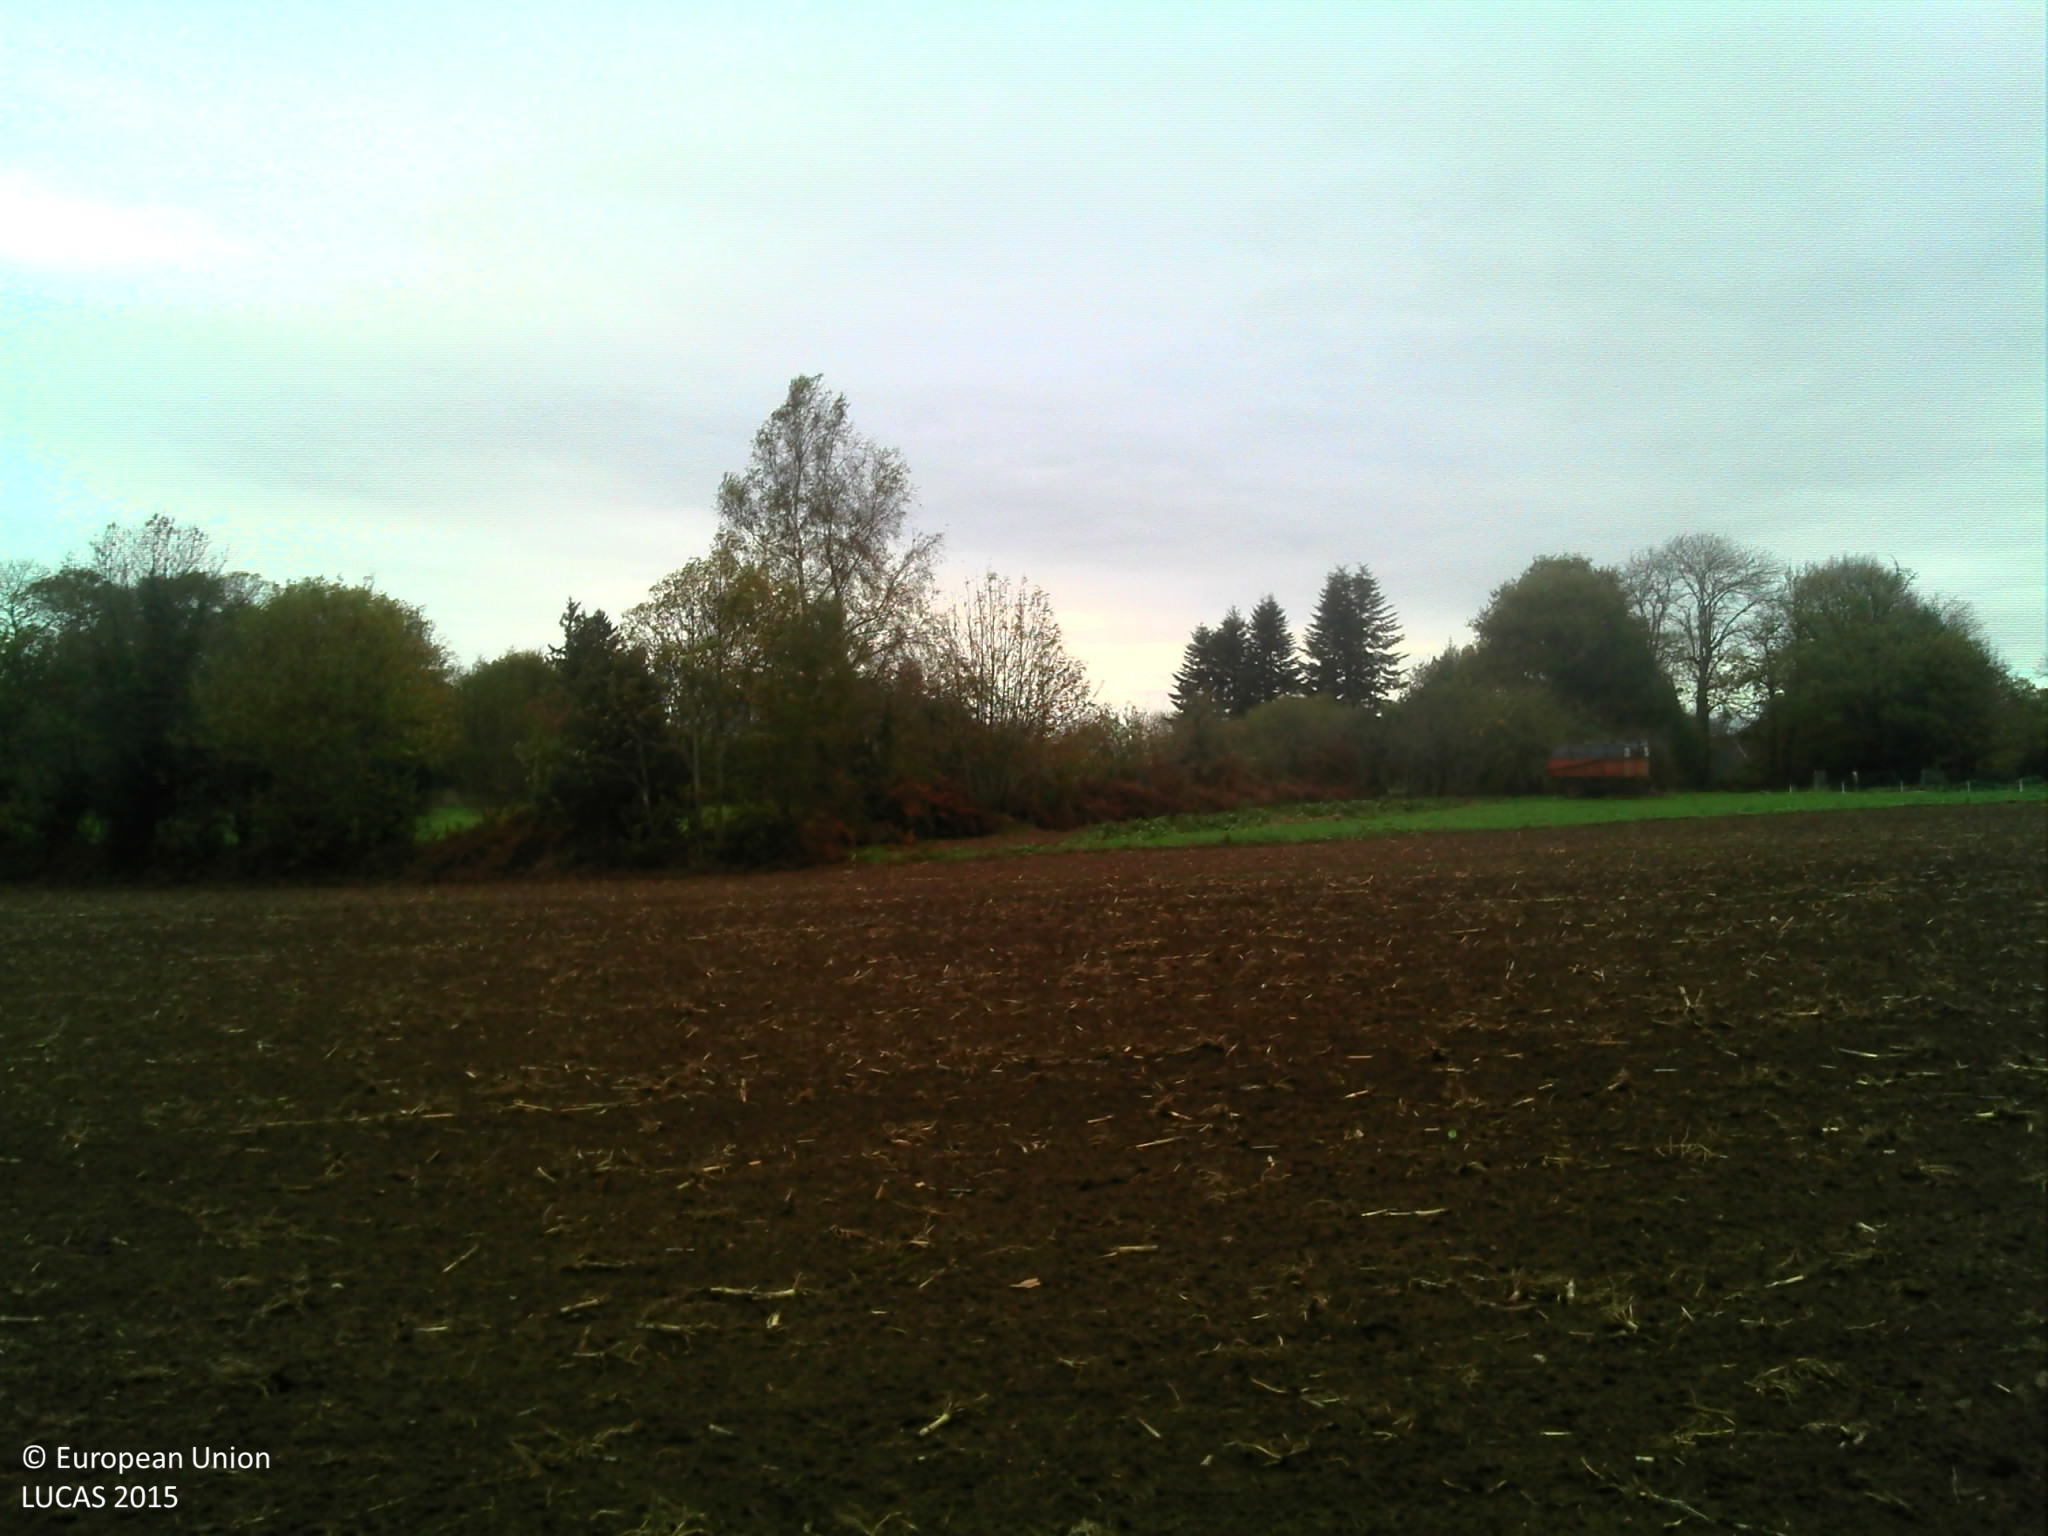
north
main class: Cropland
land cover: Barley
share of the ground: < 10 %
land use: Agriculture (excluding fallow land and kitchen gardens)
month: November
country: FR
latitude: 47.9421
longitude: -3.1498
